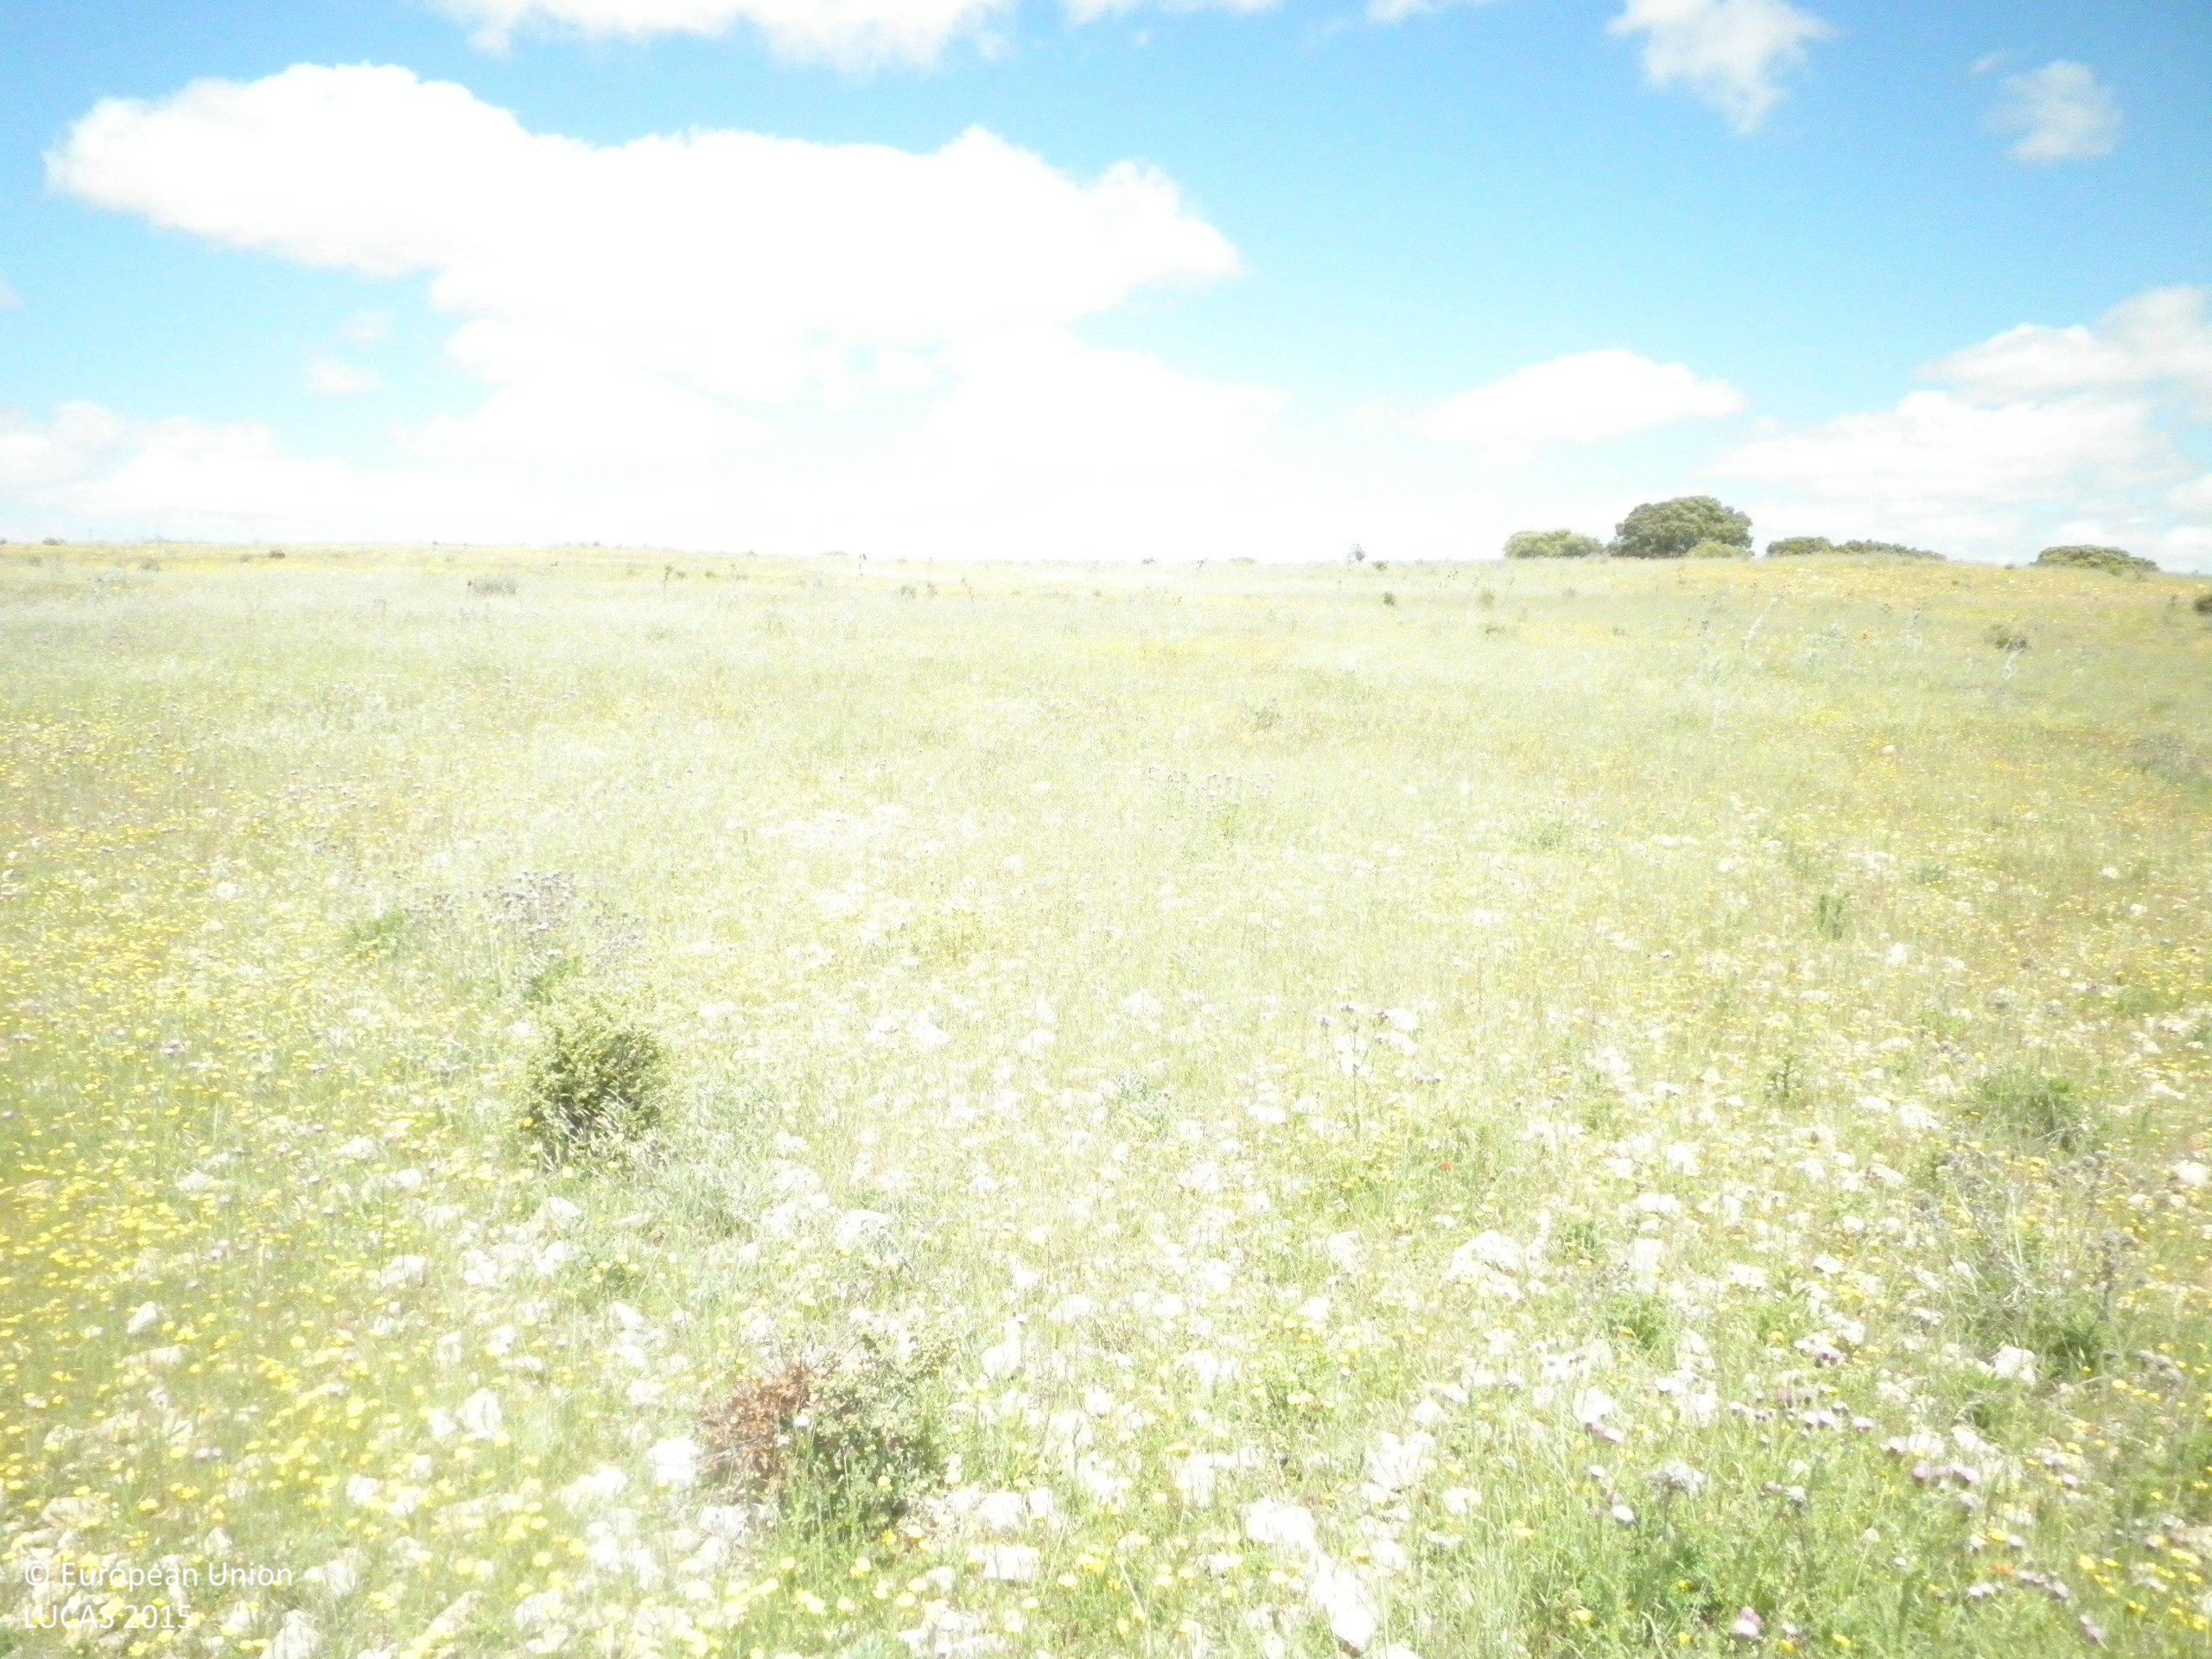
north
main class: Grassland
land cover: Spontaneously vegetated surfaces
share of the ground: > 75 %
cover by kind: herbaceous plants 60 %, unconsolidated bare surface 35 %, shrubs 5 %
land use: Semi-natural and natural areas not in use
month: May
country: ES
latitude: 39.6951
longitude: -2.8340
